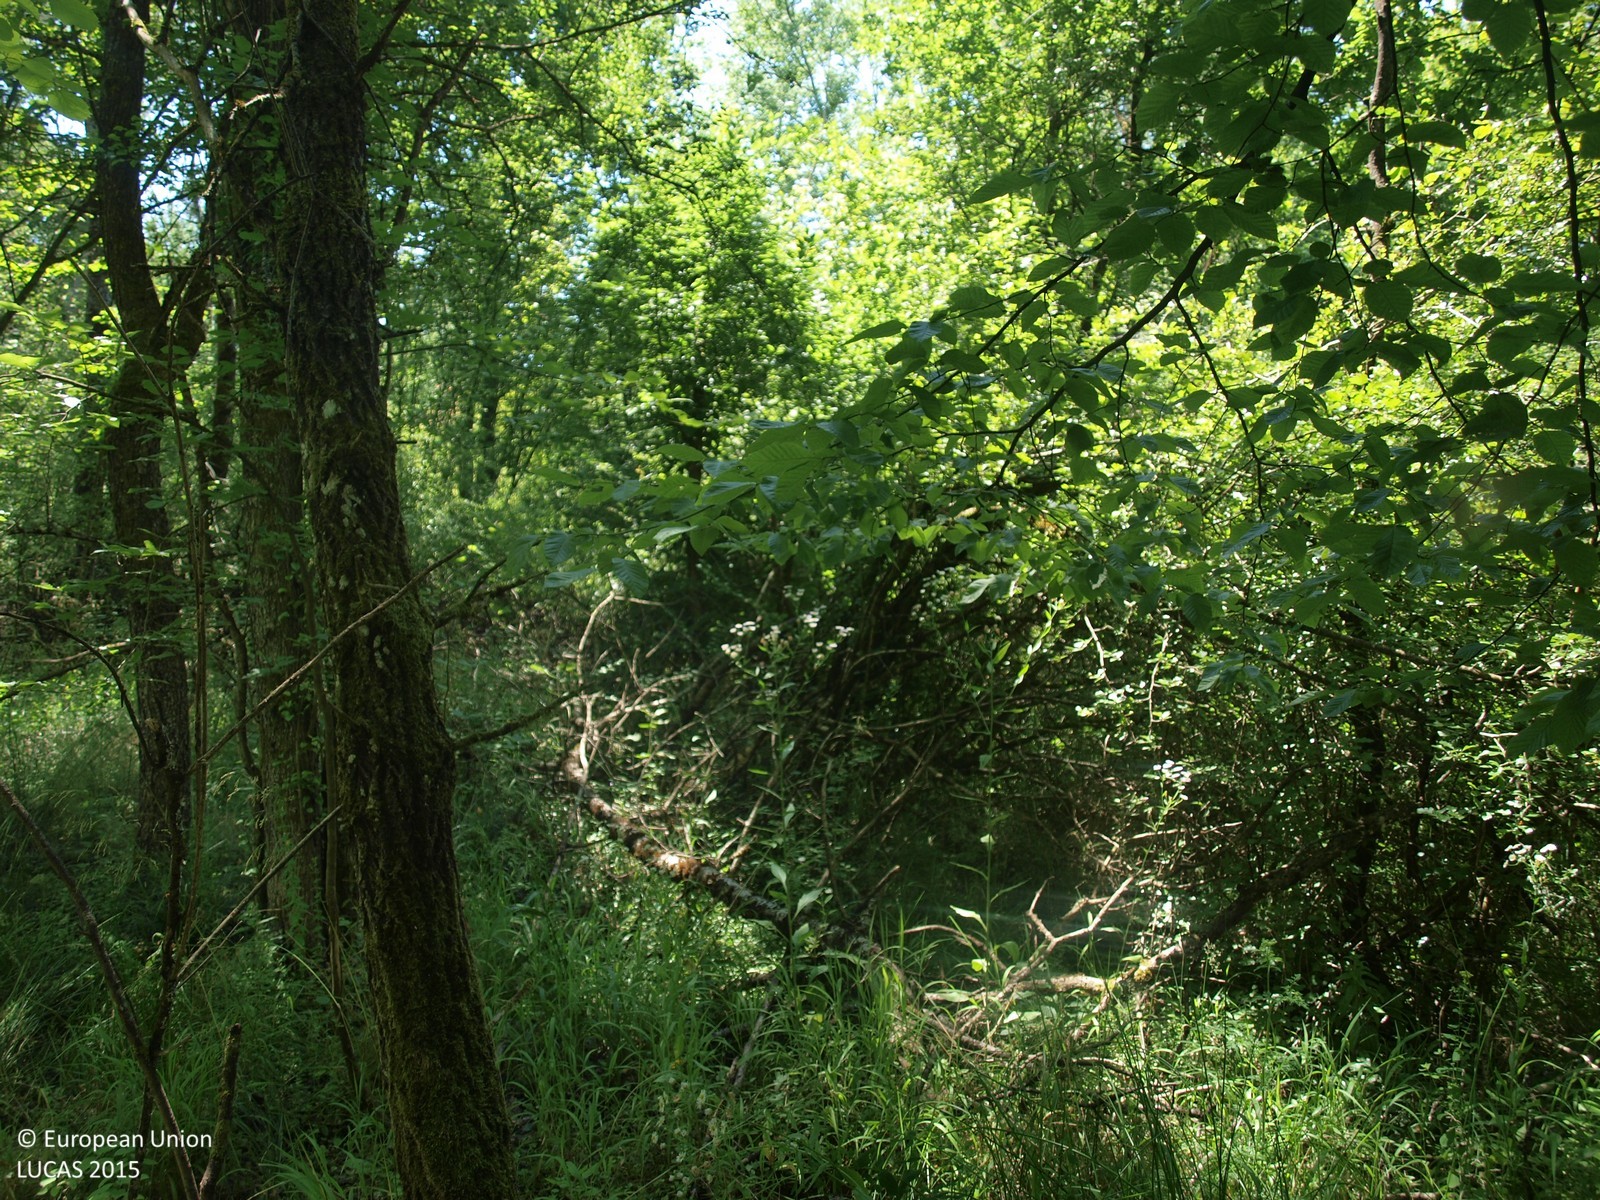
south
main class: Woodland
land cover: Broadleaved woodland
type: floodplain forest
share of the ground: > 75 %
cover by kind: broadleaved forest trees 100 %
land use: Forestry
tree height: > 5 m
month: July
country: HR
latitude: 45.6405
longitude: 15.6804
